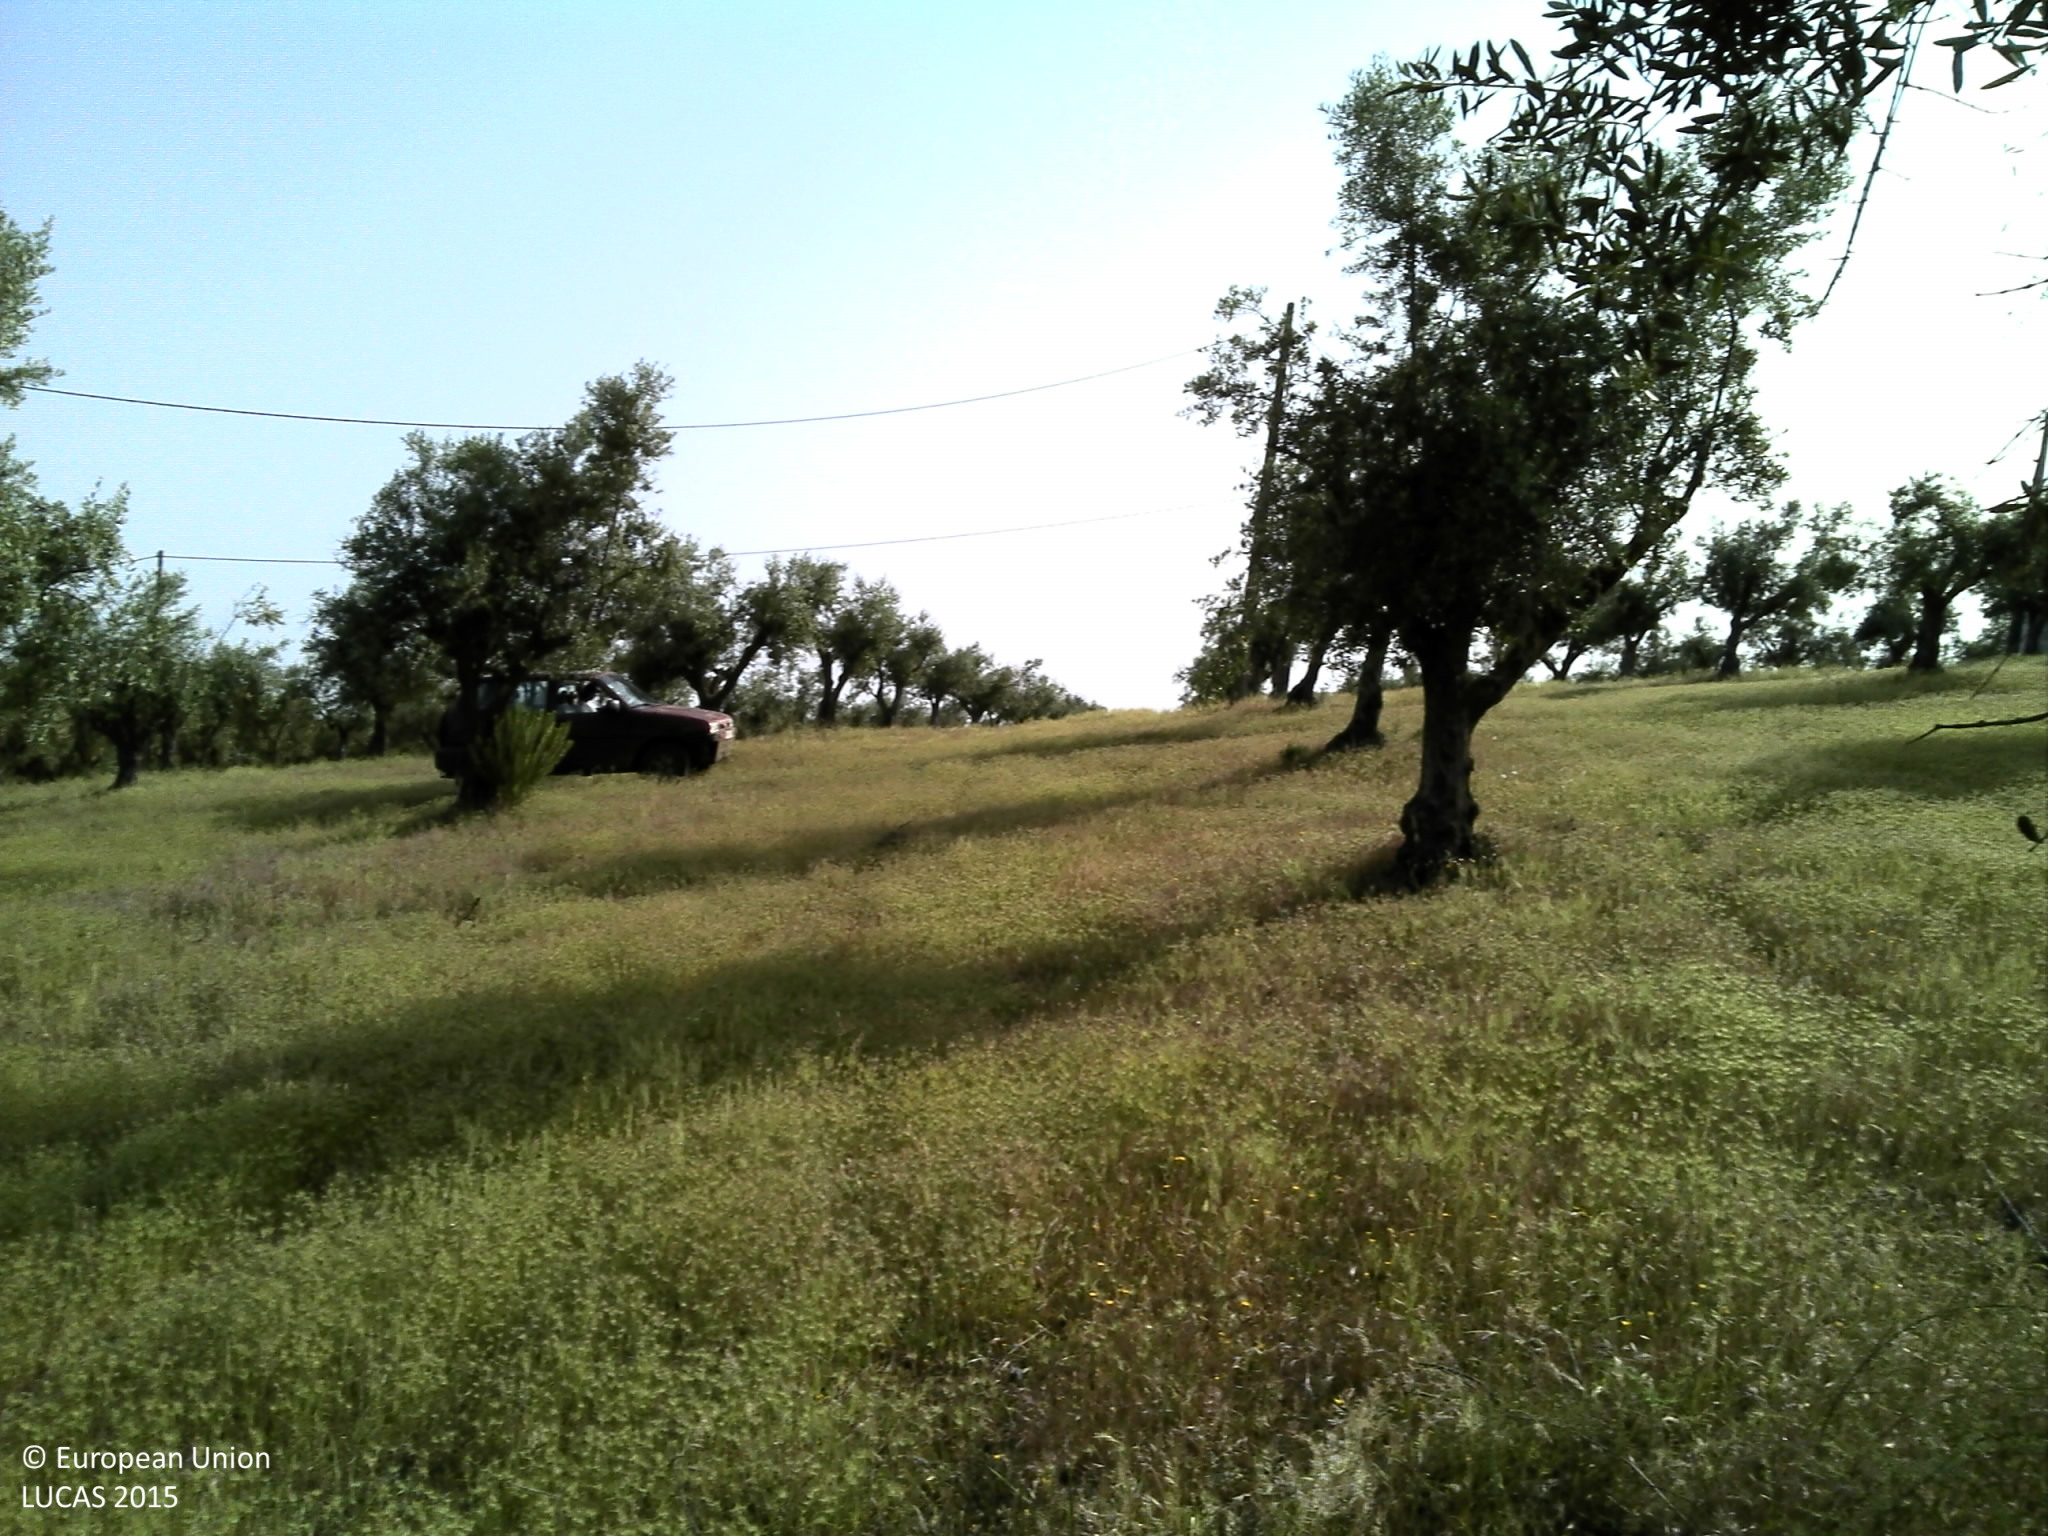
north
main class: Cropland
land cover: Olive groves
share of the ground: 25 - 50 %
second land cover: Grassland without tree/shrub cover
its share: 50 - 75 %
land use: Agriculture (excluding fallow land and kitchen gardens)
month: May
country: PT
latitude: 39.0136
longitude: -7.7958
